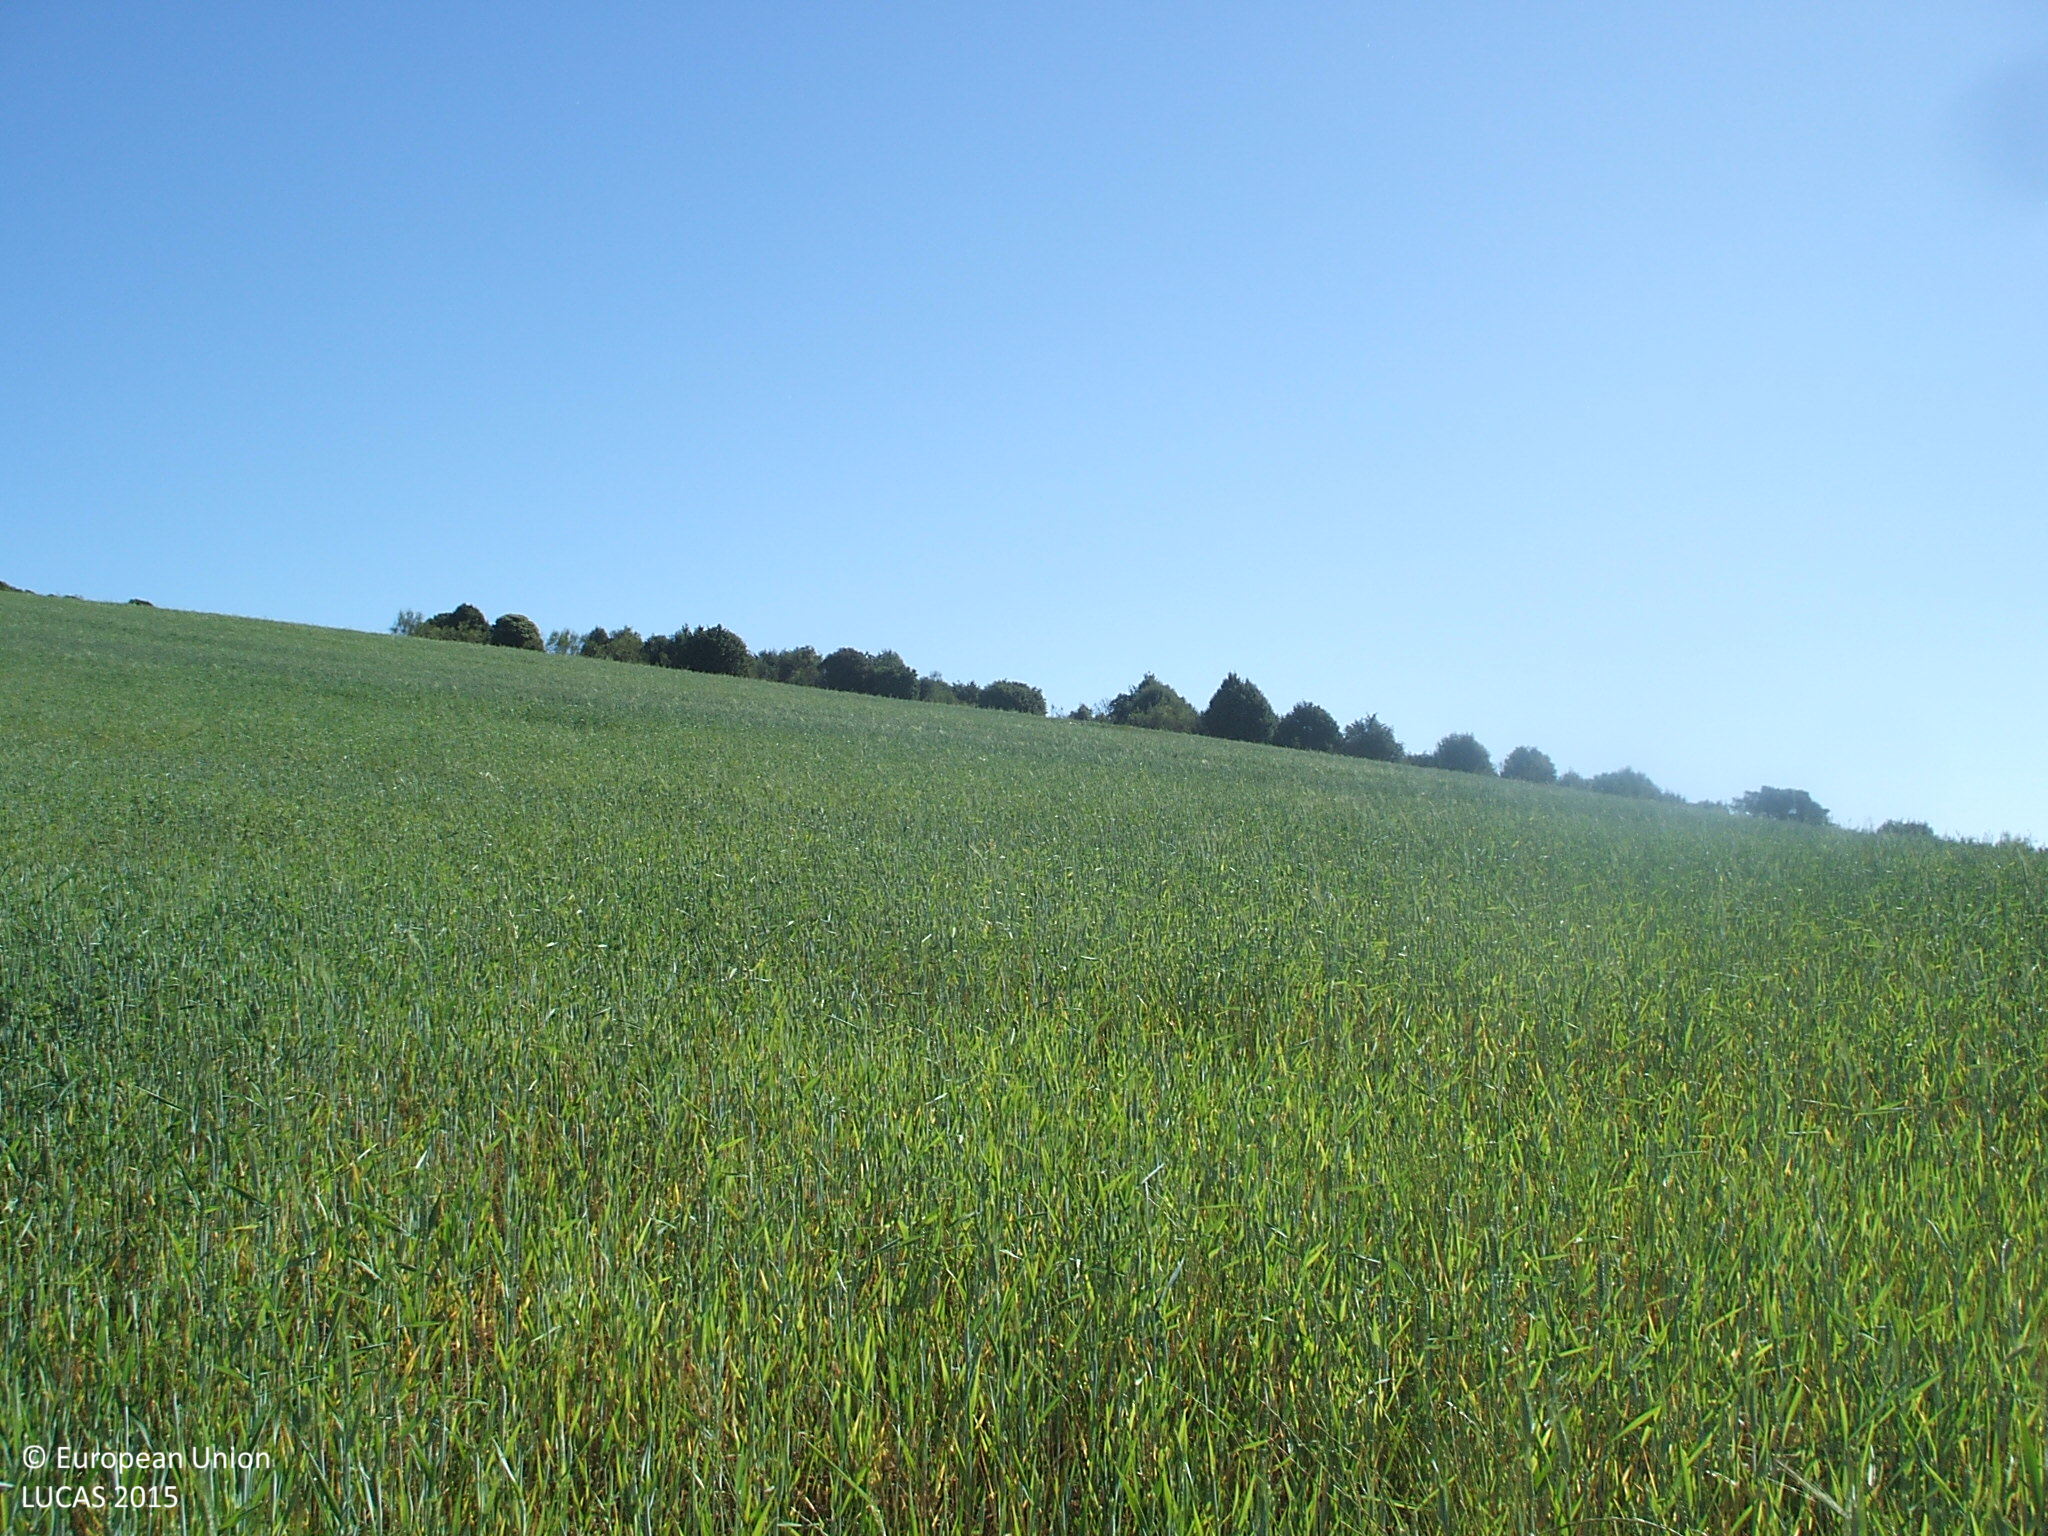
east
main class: Cropland
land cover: Common wheat
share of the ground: > 75 %
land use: Agriculture (excluding fallow land and kitchen gardens)
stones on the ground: > 50 %
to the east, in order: Common wheat; Shrubland with sparse tree cover; Broadleaved woodland; Shrubland with sparse tree cover
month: May
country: ES
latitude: 40.8712
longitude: -3.3396
